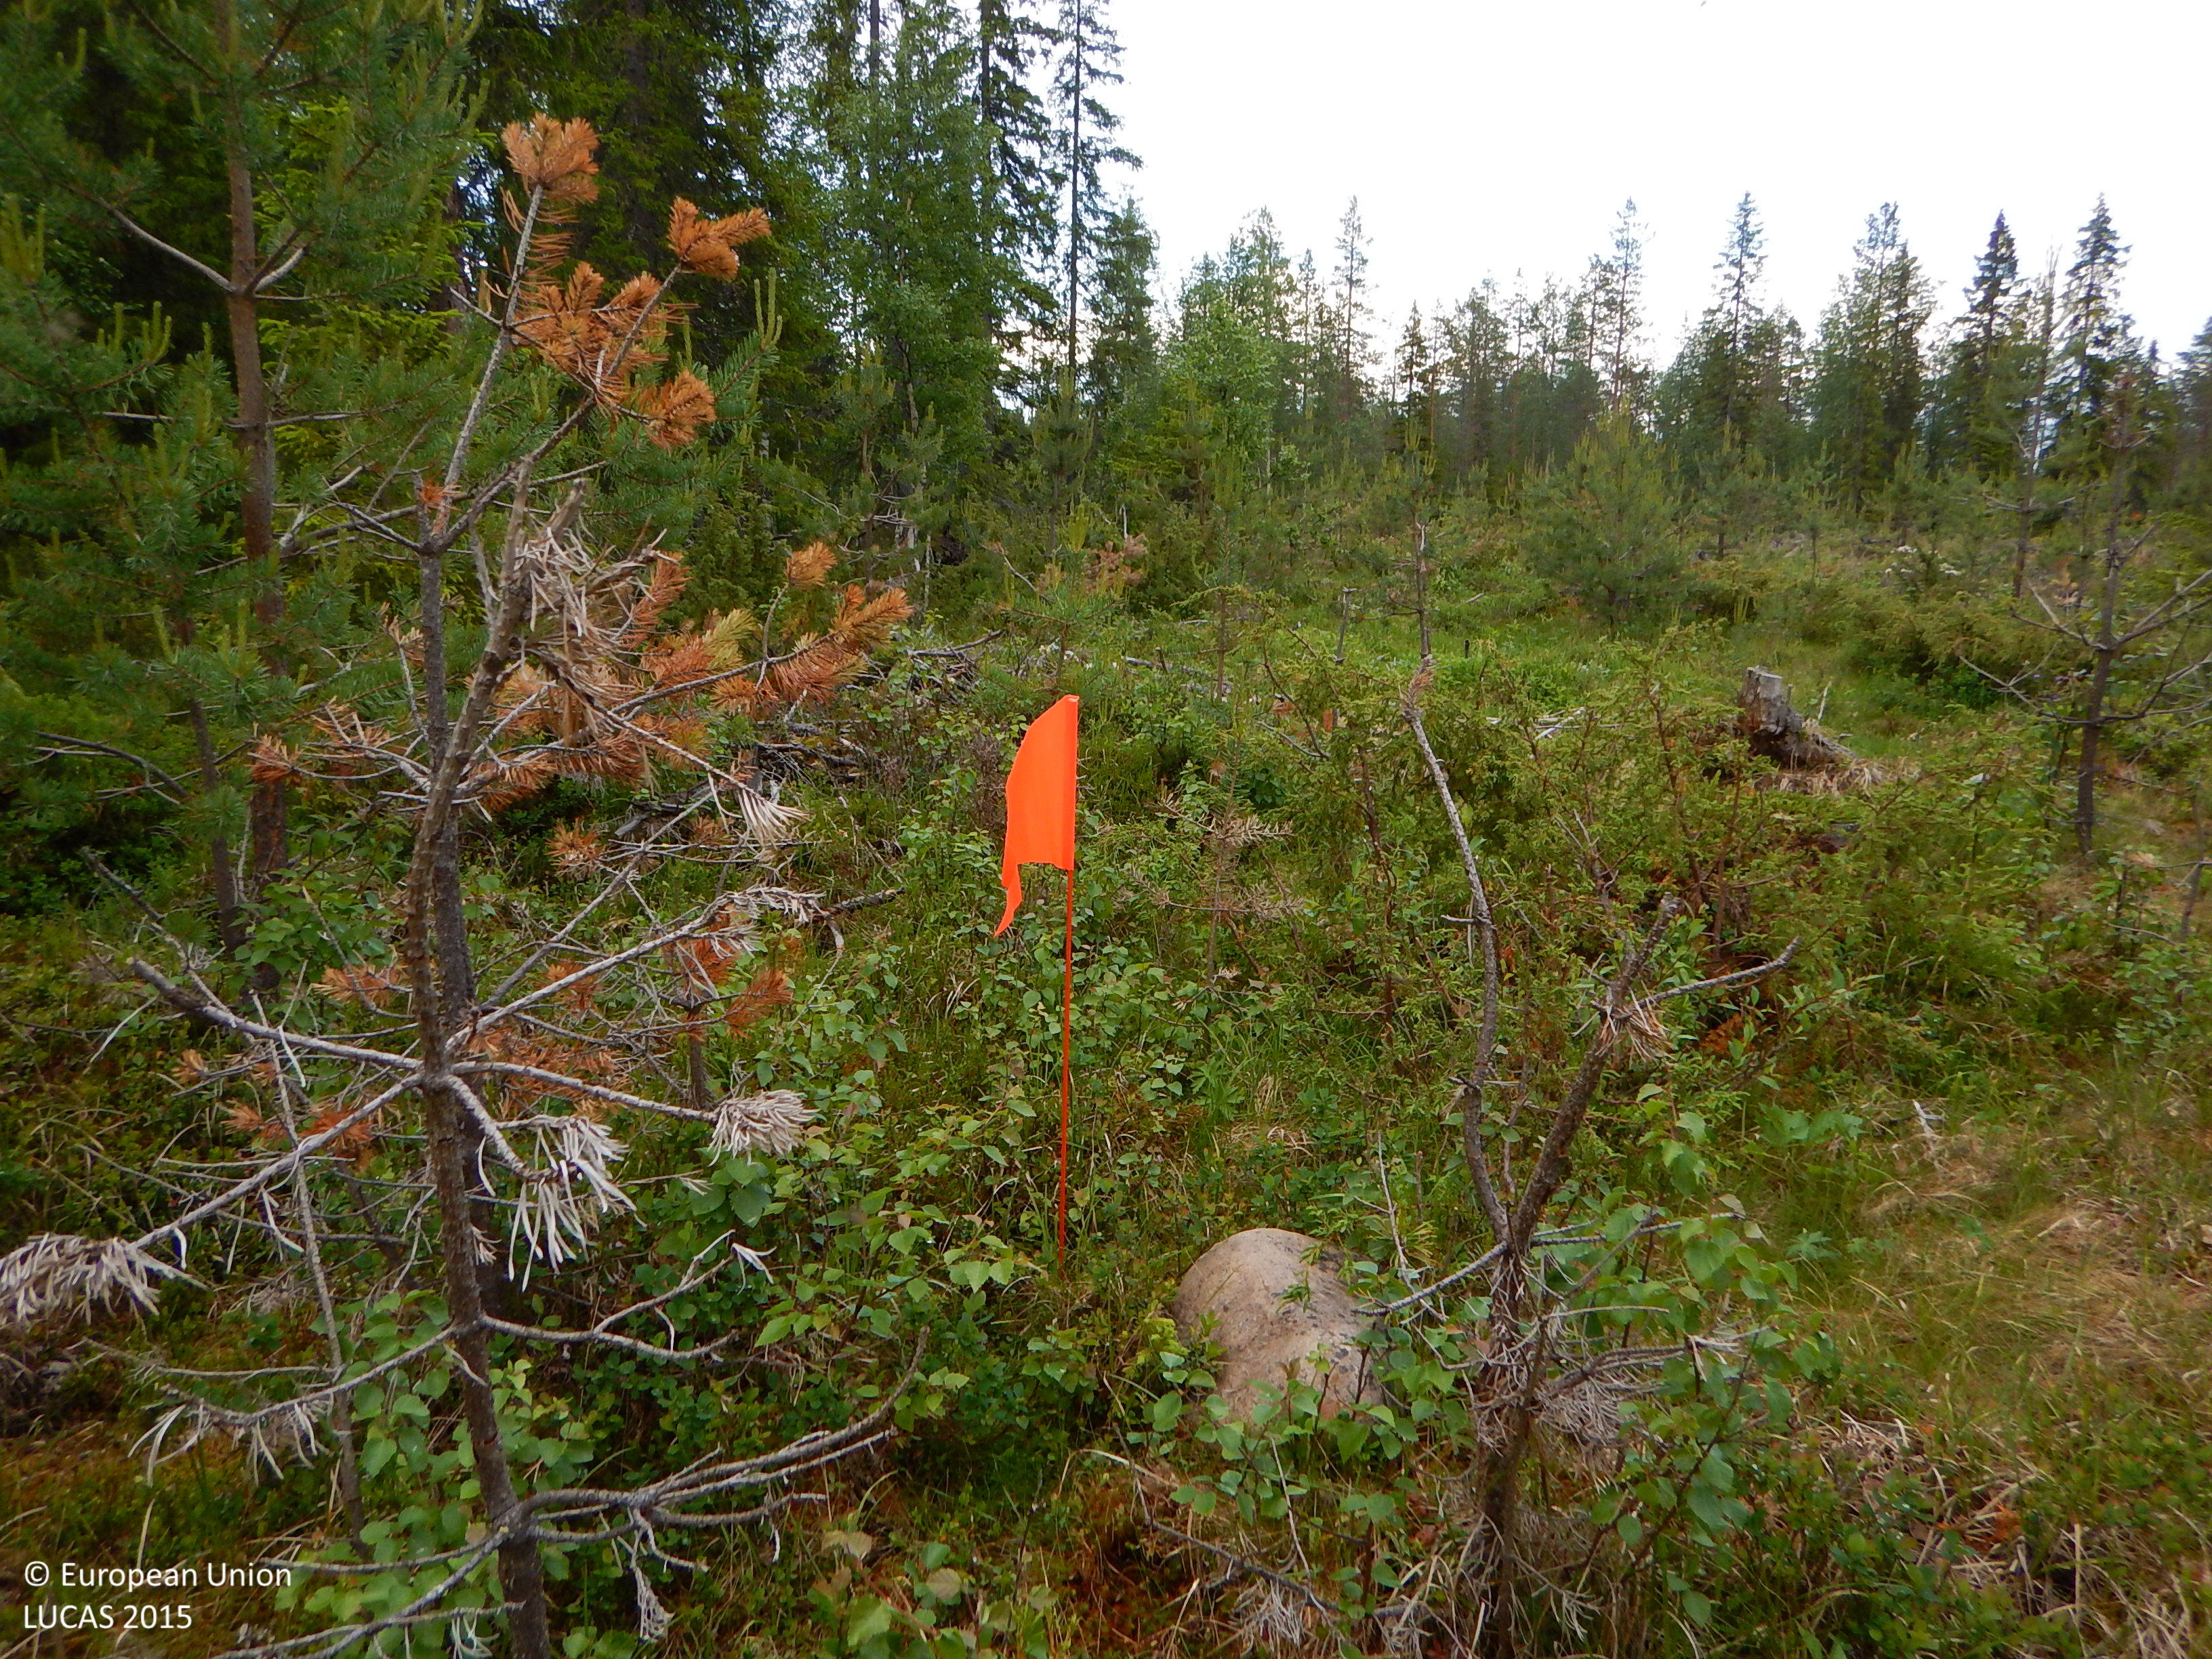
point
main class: Woodland
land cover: Pine dominated coniferous woodland
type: boreal forest
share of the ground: 10 - 25 %
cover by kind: herbaceous plants 45 %, coniferous forest trees 15 %, consolidated bare surface 15 %, shrubs 10 %, lichens and mosses 10 %, broadleaved forest trees 5 %
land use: Forestry
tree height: < 5 m
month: July
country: SE
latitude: 65.2554
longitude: 19.2778
